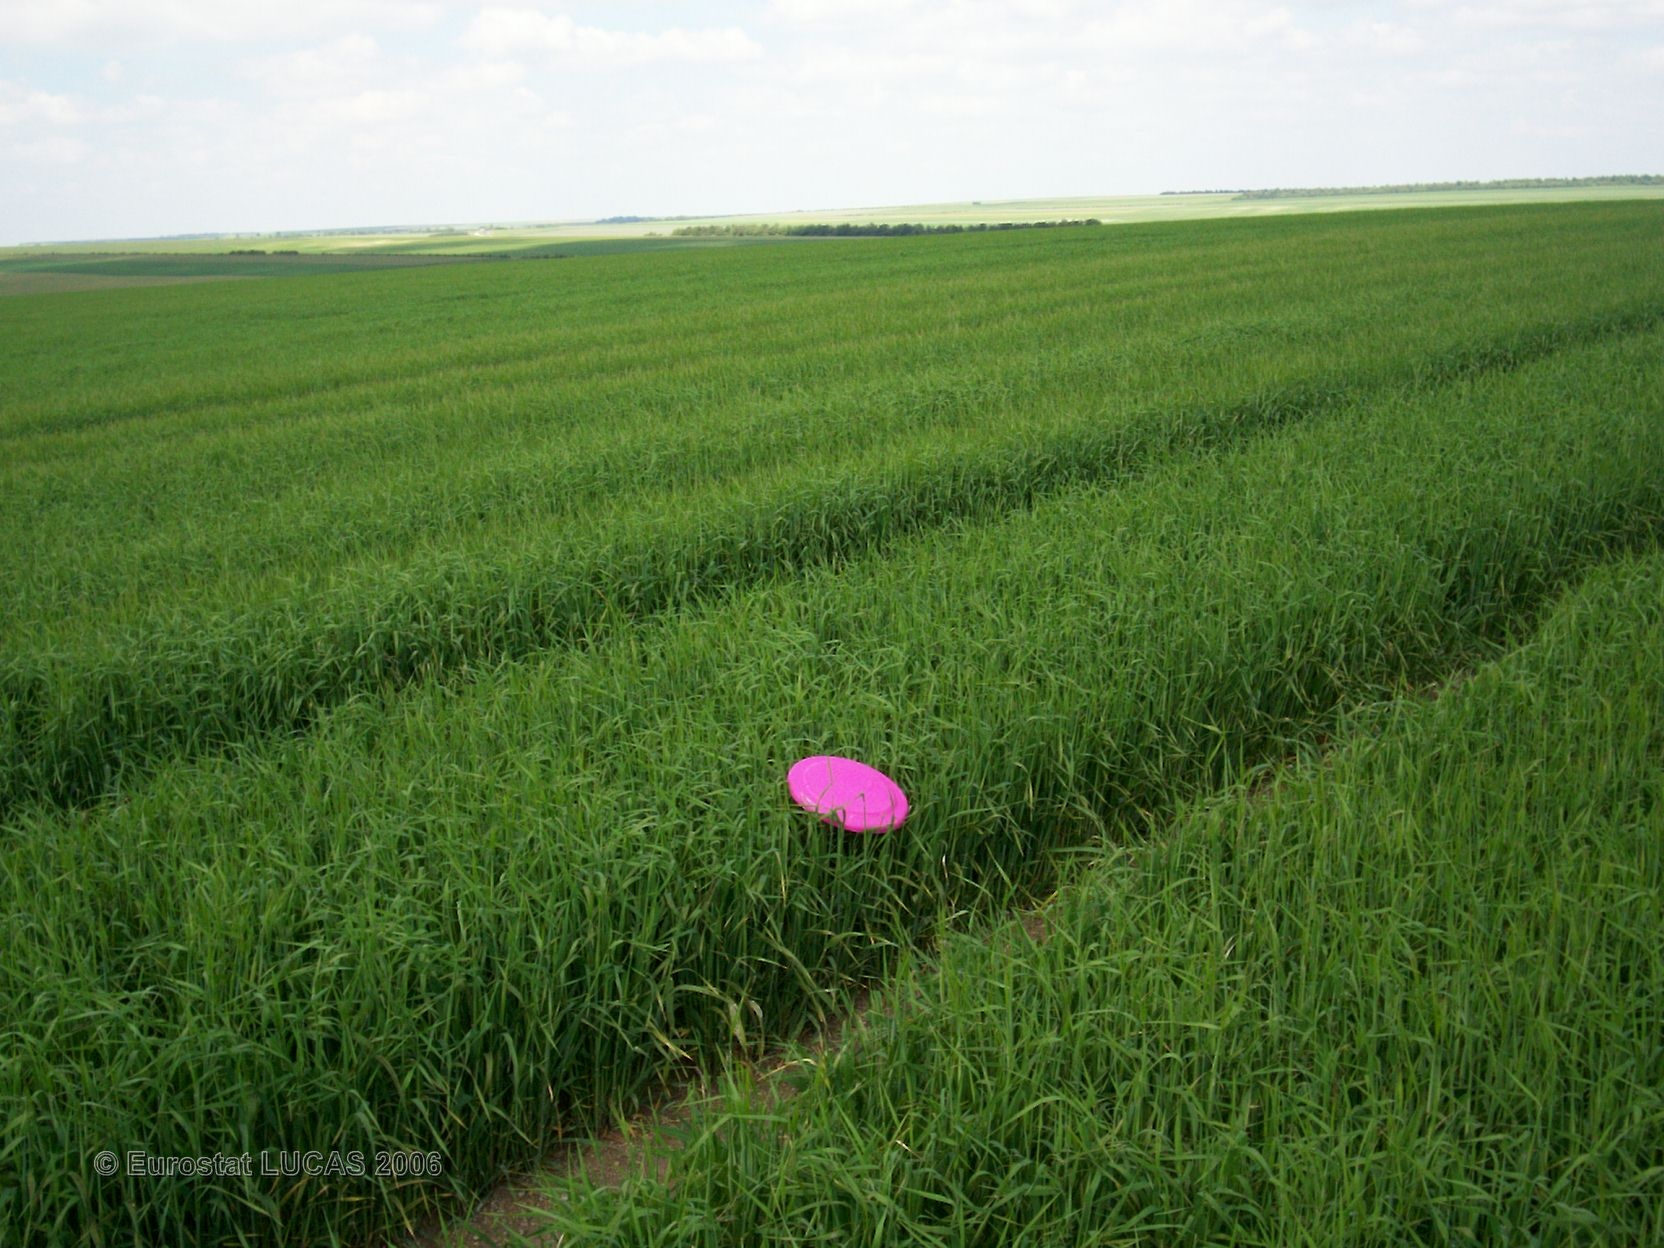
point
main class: Cropland
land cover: Barley
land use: Agriculture (excluding fallow land and kitchen gardens)
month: June
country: FR
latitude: 48.7695
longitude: 4.4591
